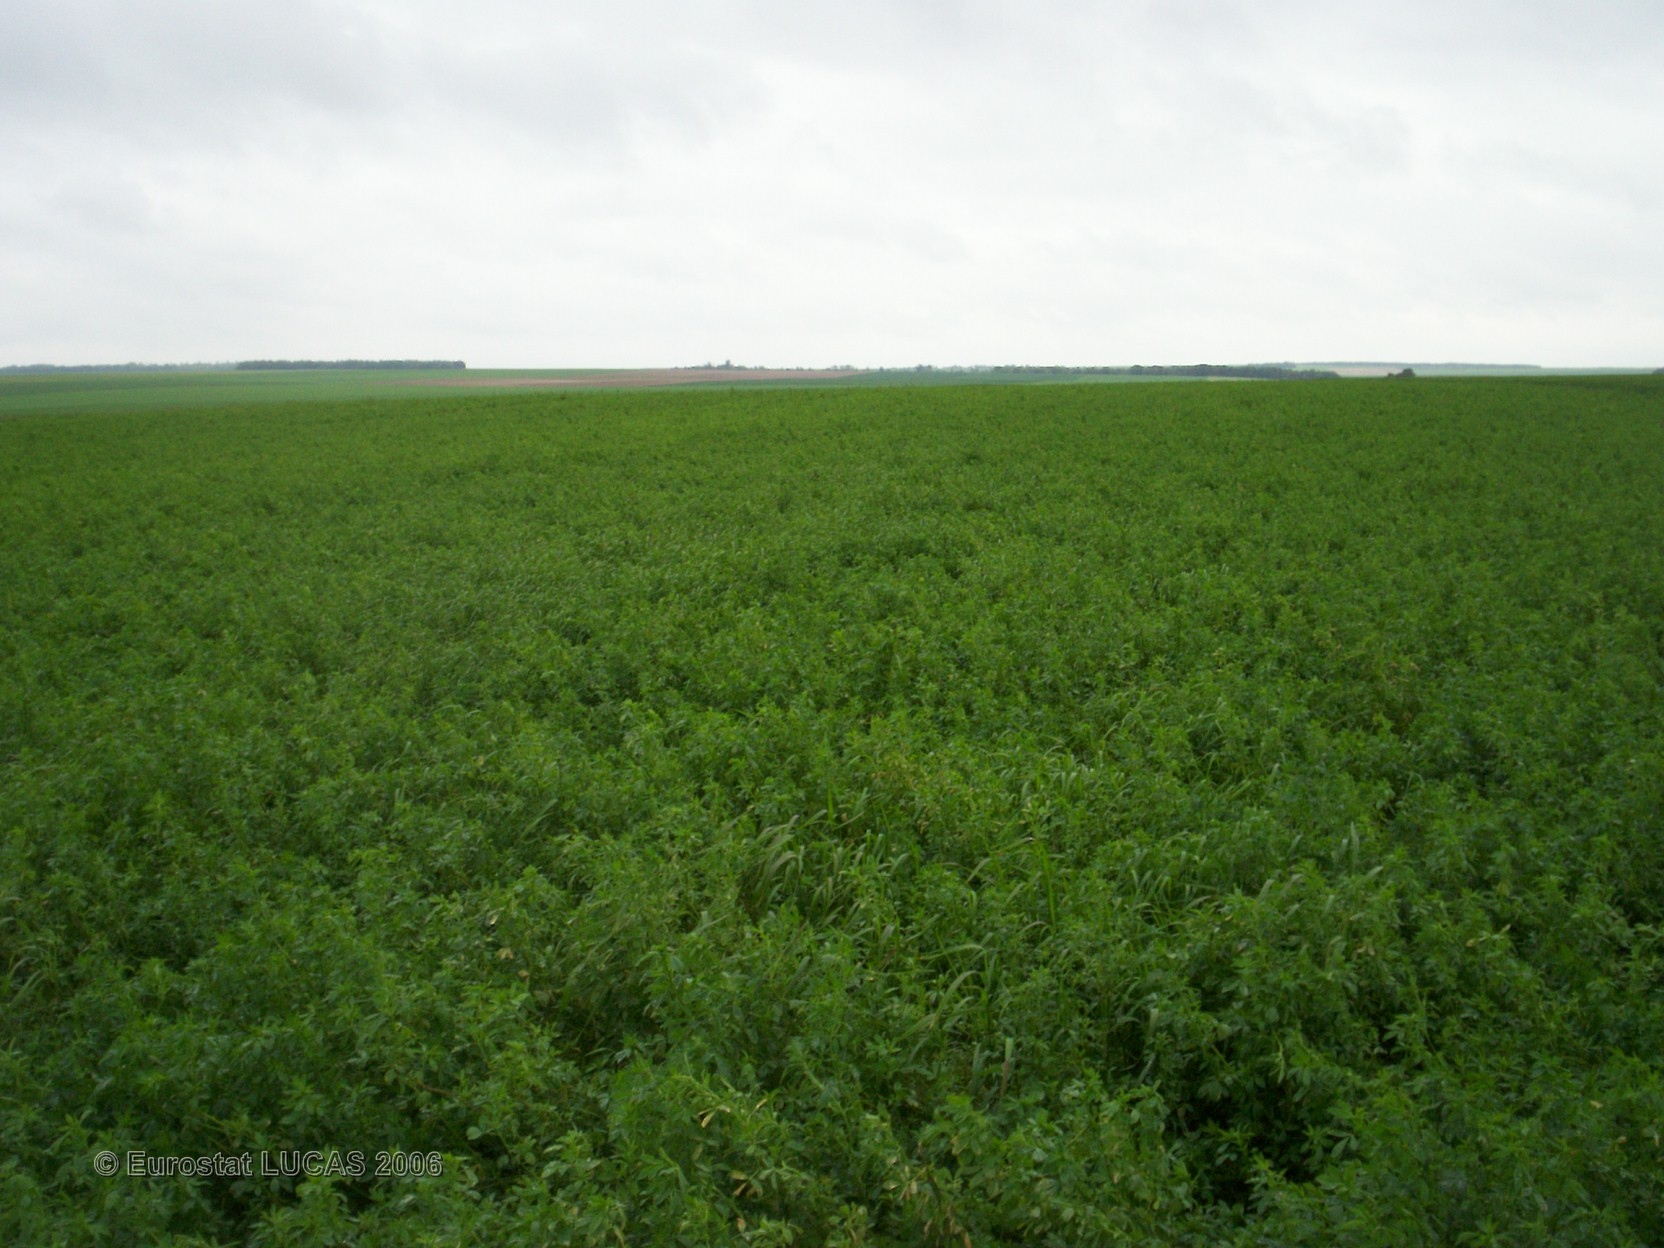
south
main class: Cropland
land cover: Lucerne
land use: Agriculture (excluding fallow land and kitchen gardens)
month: May
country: FR
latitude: 49.3805
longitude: 4.4175
